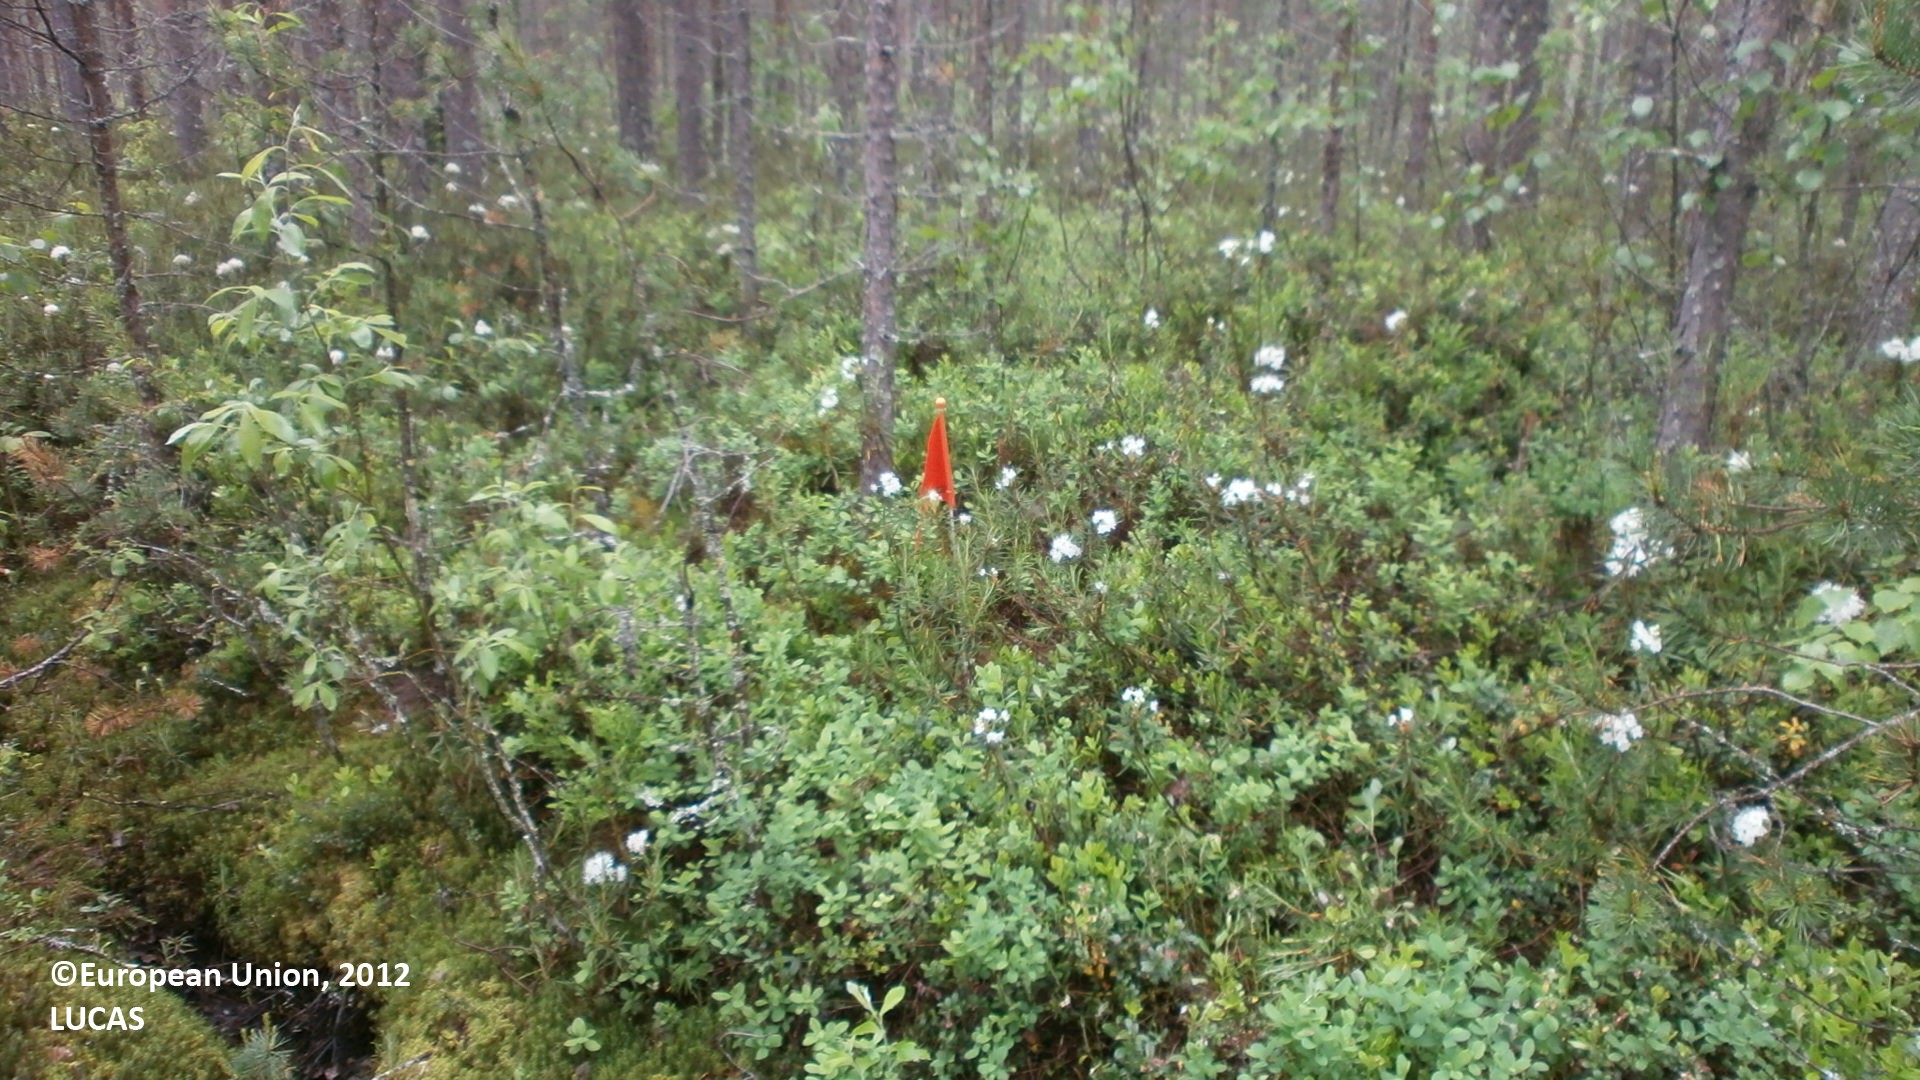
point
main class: Woodland
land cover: Pine dominated coniferous woodland
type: mire and swamp forests
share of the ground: > 75 %
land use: Forestry
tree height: > 5 m
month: June
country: FI
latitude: 64.7782
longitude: 25.2884
